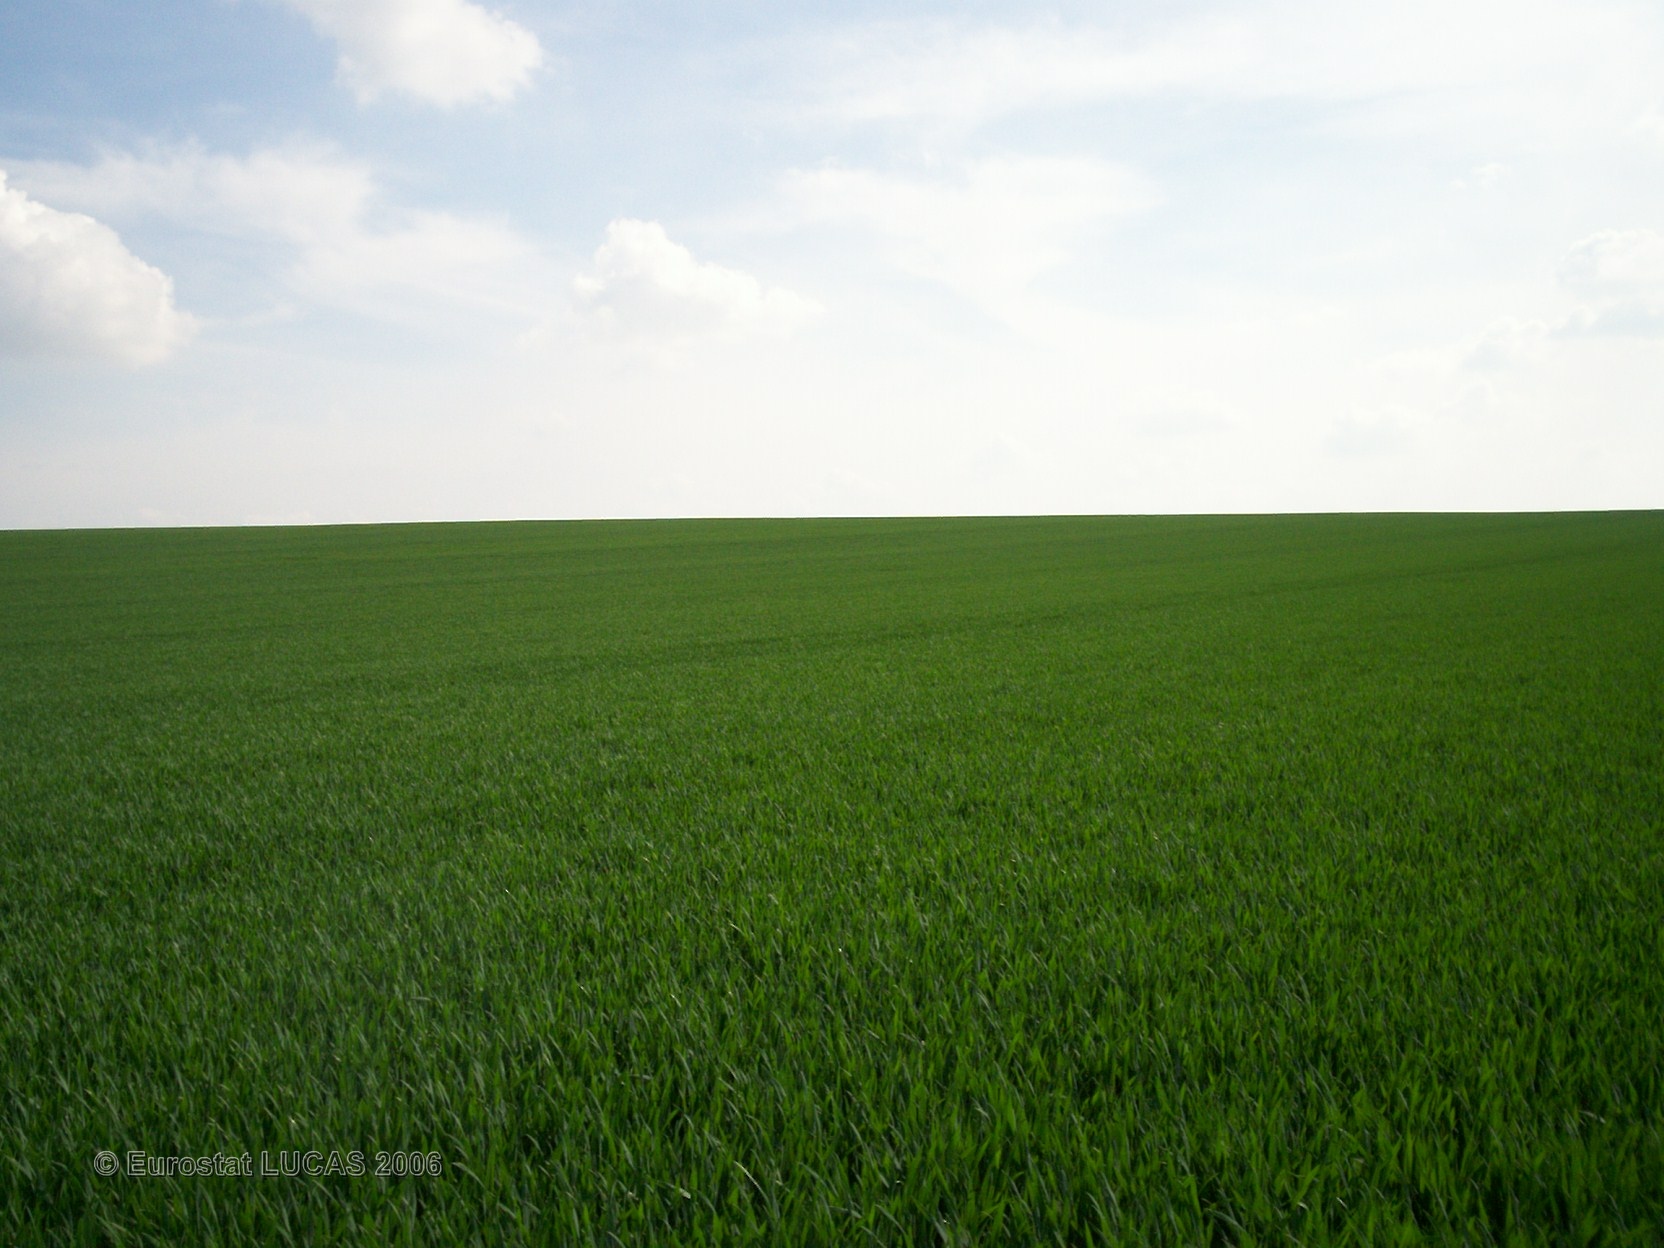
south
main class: Cropland
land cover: Common wheat
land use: Agriculture (excluding fallow land and kitchen gardens)
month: May
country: FR
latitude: 48.8923
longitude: 4.3907
